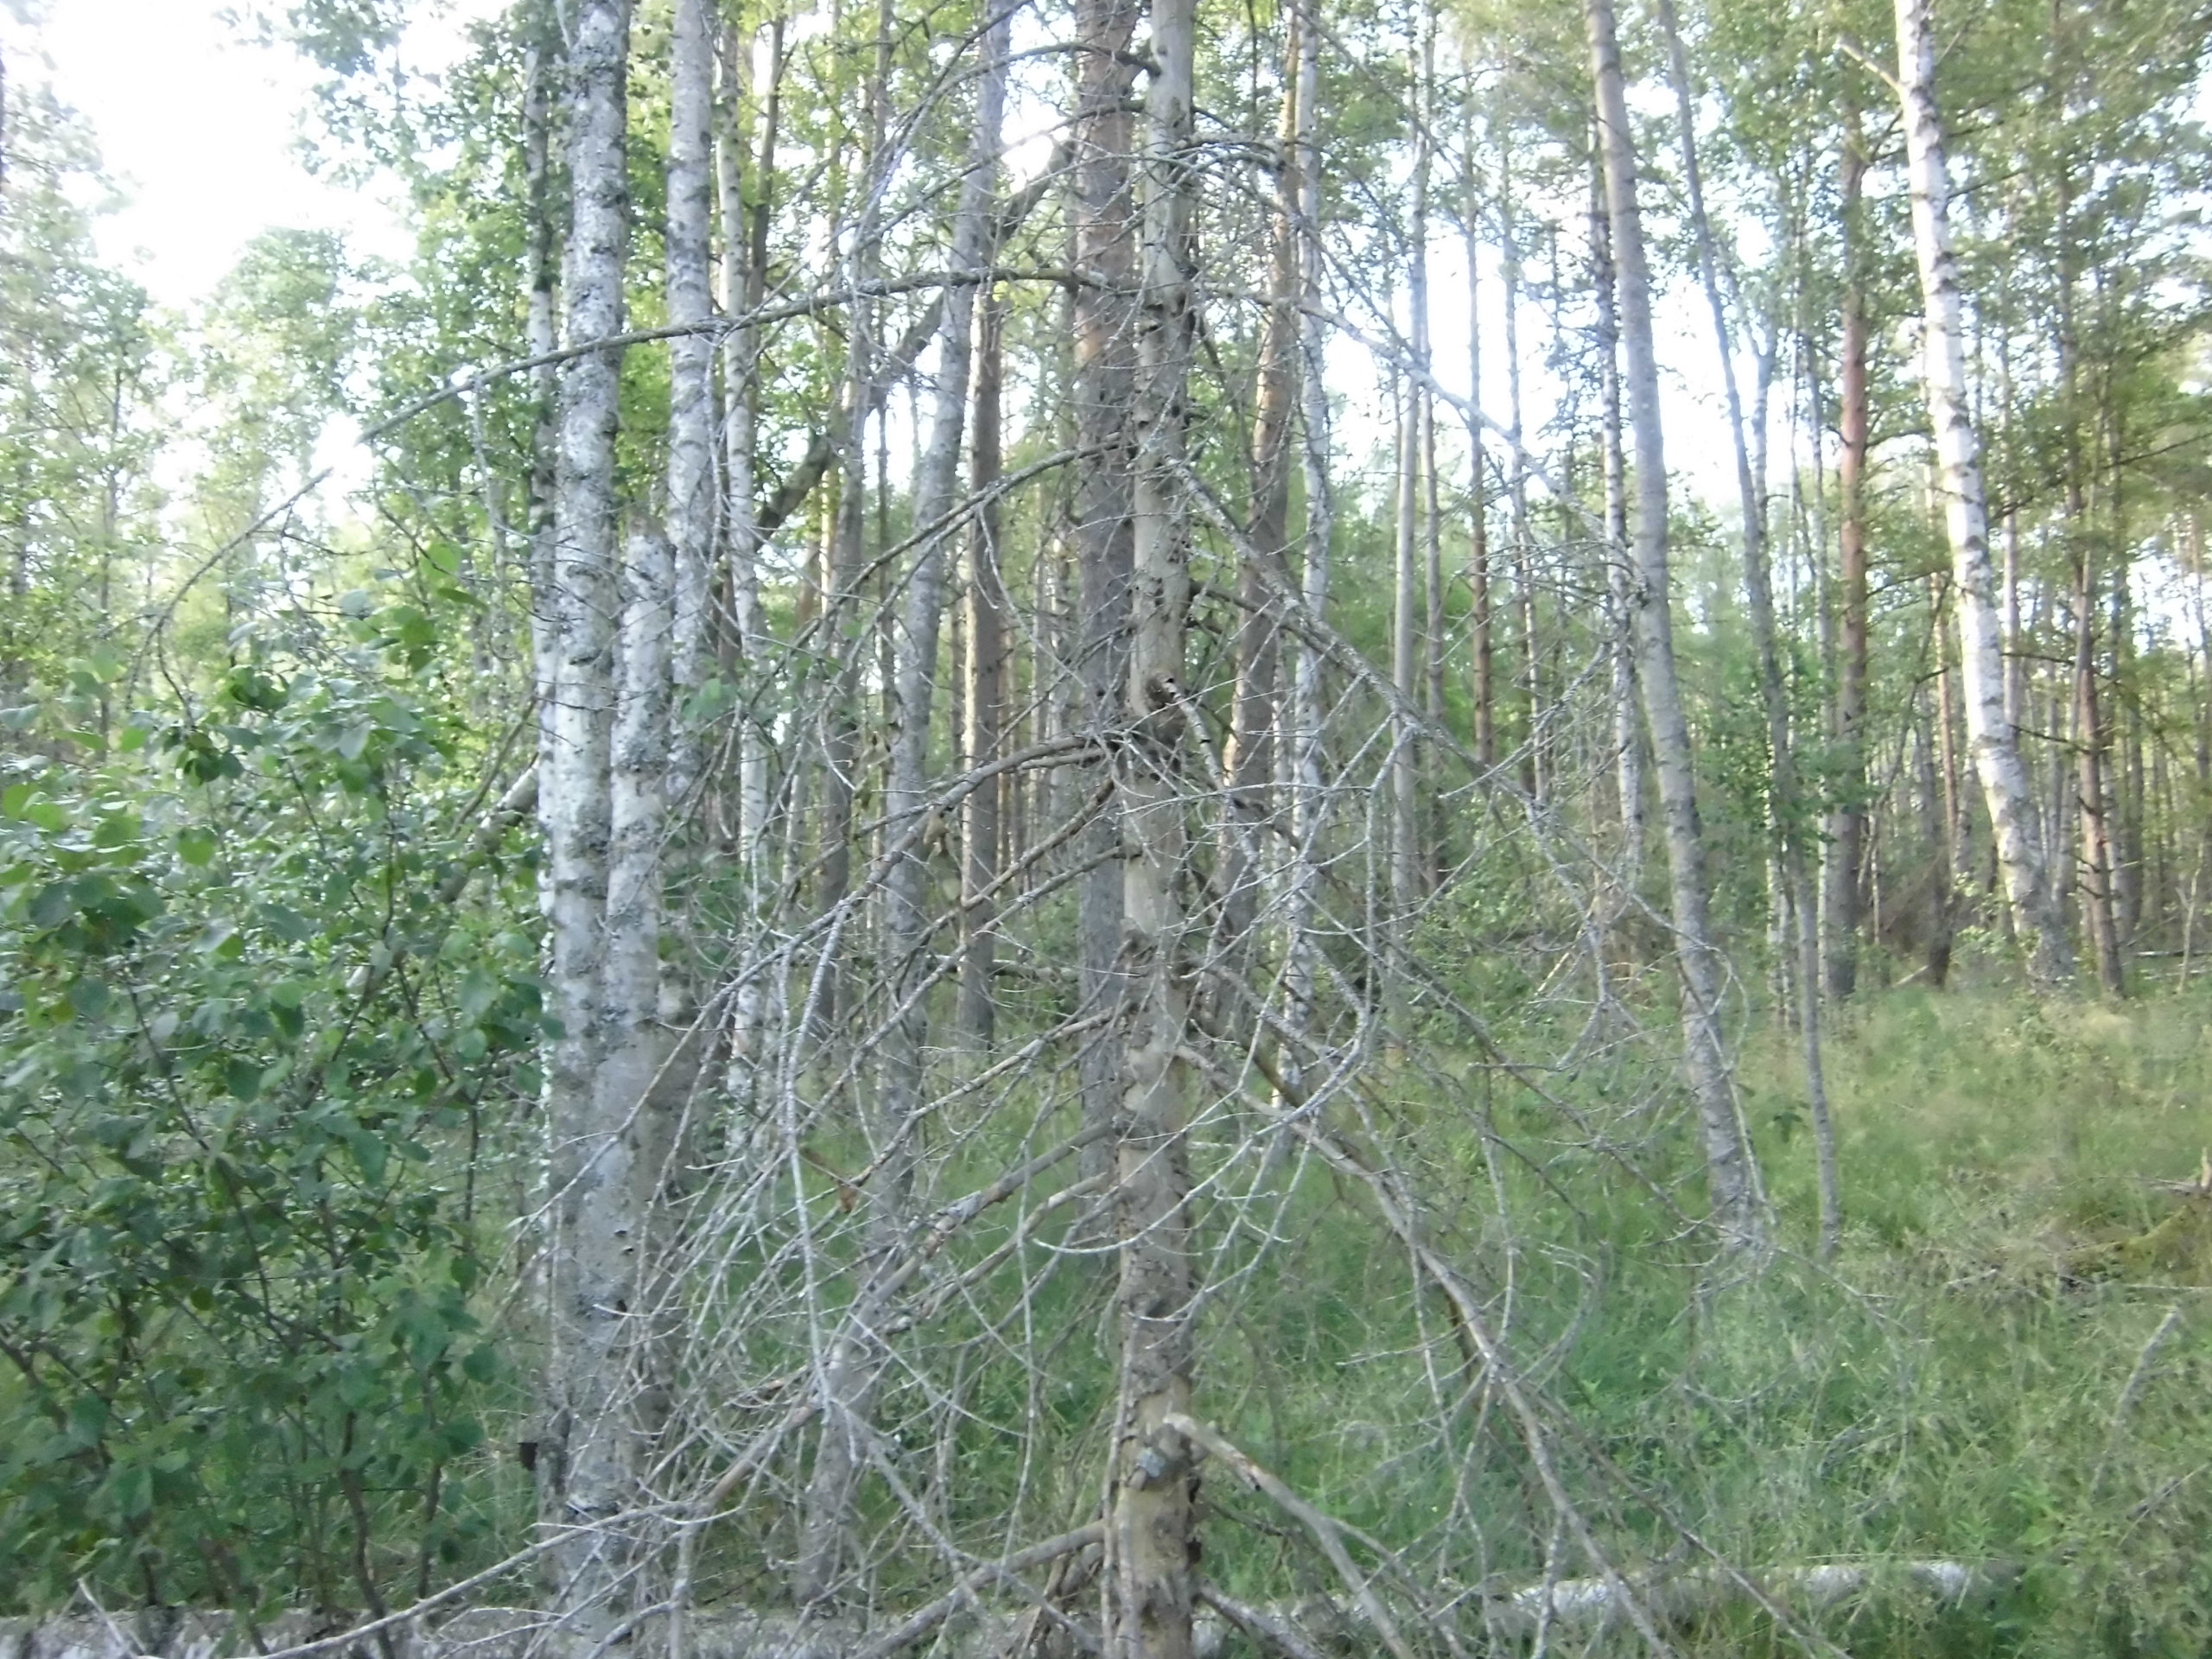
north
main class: Woodland
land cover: Pine dominated mixed woodland
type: boreal forest
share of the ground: 50 - 75 %
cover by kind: broadleaved forest trees 35 %, herbaceous plants 35 %, coniferous forest trees 25 %, shrubs 5 %
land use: Forestry
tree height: > 5 m
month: July
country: SE
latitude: 57.2464
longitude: 15.3832
